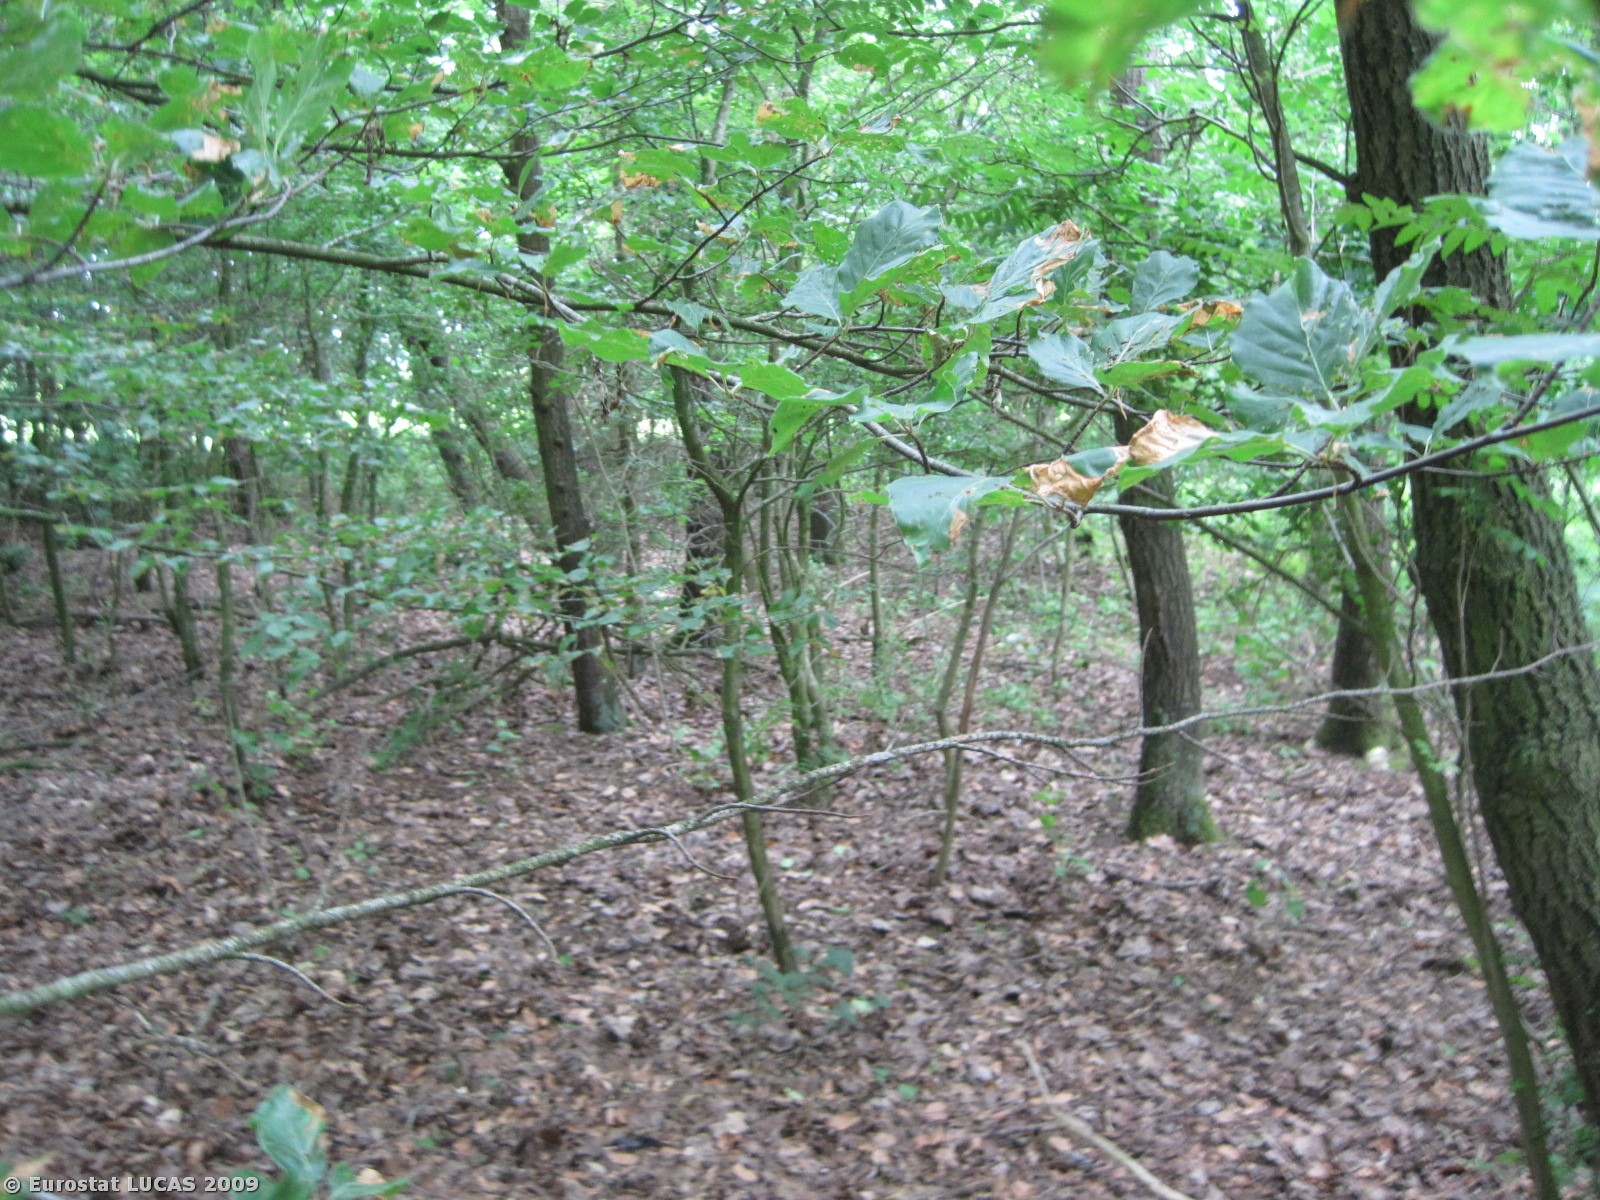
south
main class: Woodland
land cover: Broadleaved woodland
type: plantations and self-sown exotic forest
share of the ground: > 75 %
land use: Unused
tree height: > 5 m
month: June
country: DK
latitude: 57.2124
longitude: 10.0496
